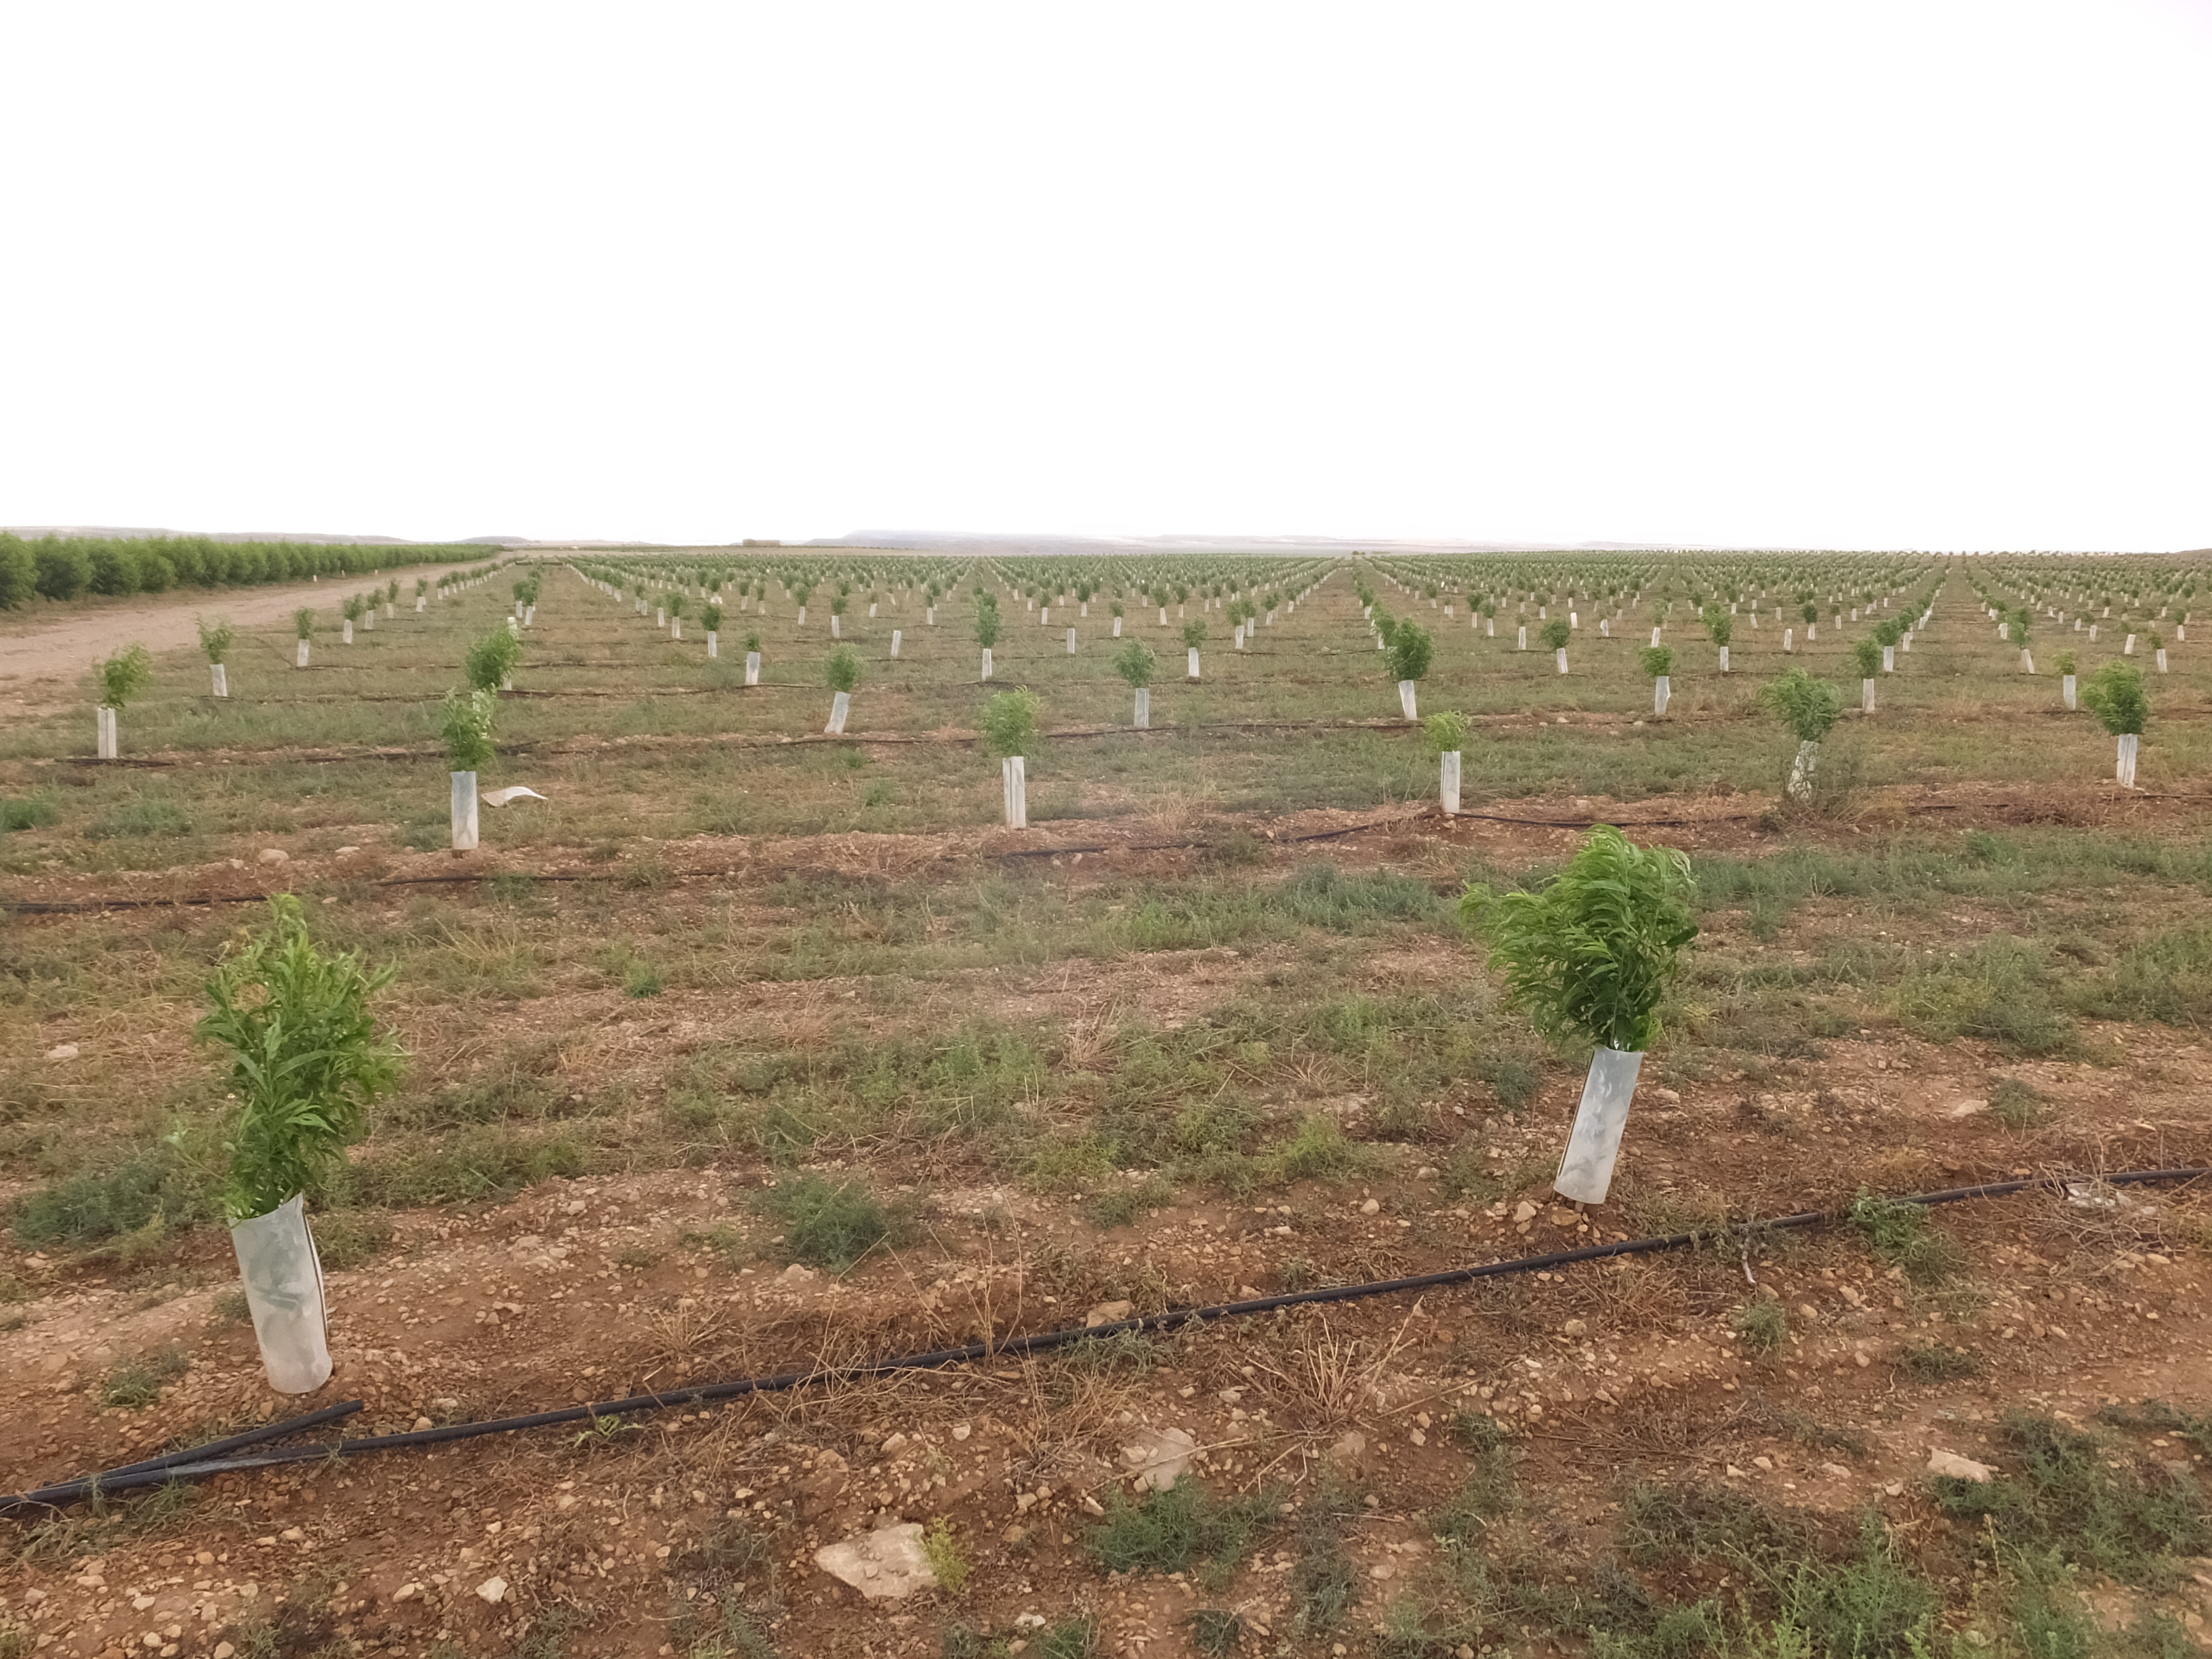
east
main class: Cropland
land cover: Other fruit trees and berries
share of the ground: < 10 %
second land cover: Spontaneously vegetated surfaces
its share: 50 - 75 %
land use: Agriculture (excluding fallow land and kitchen gardens)
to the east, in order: Other fruit trees and berries; Spontaneously vegetated surfaces
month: June
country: ES
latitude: 41.6338
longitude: 0.0330
